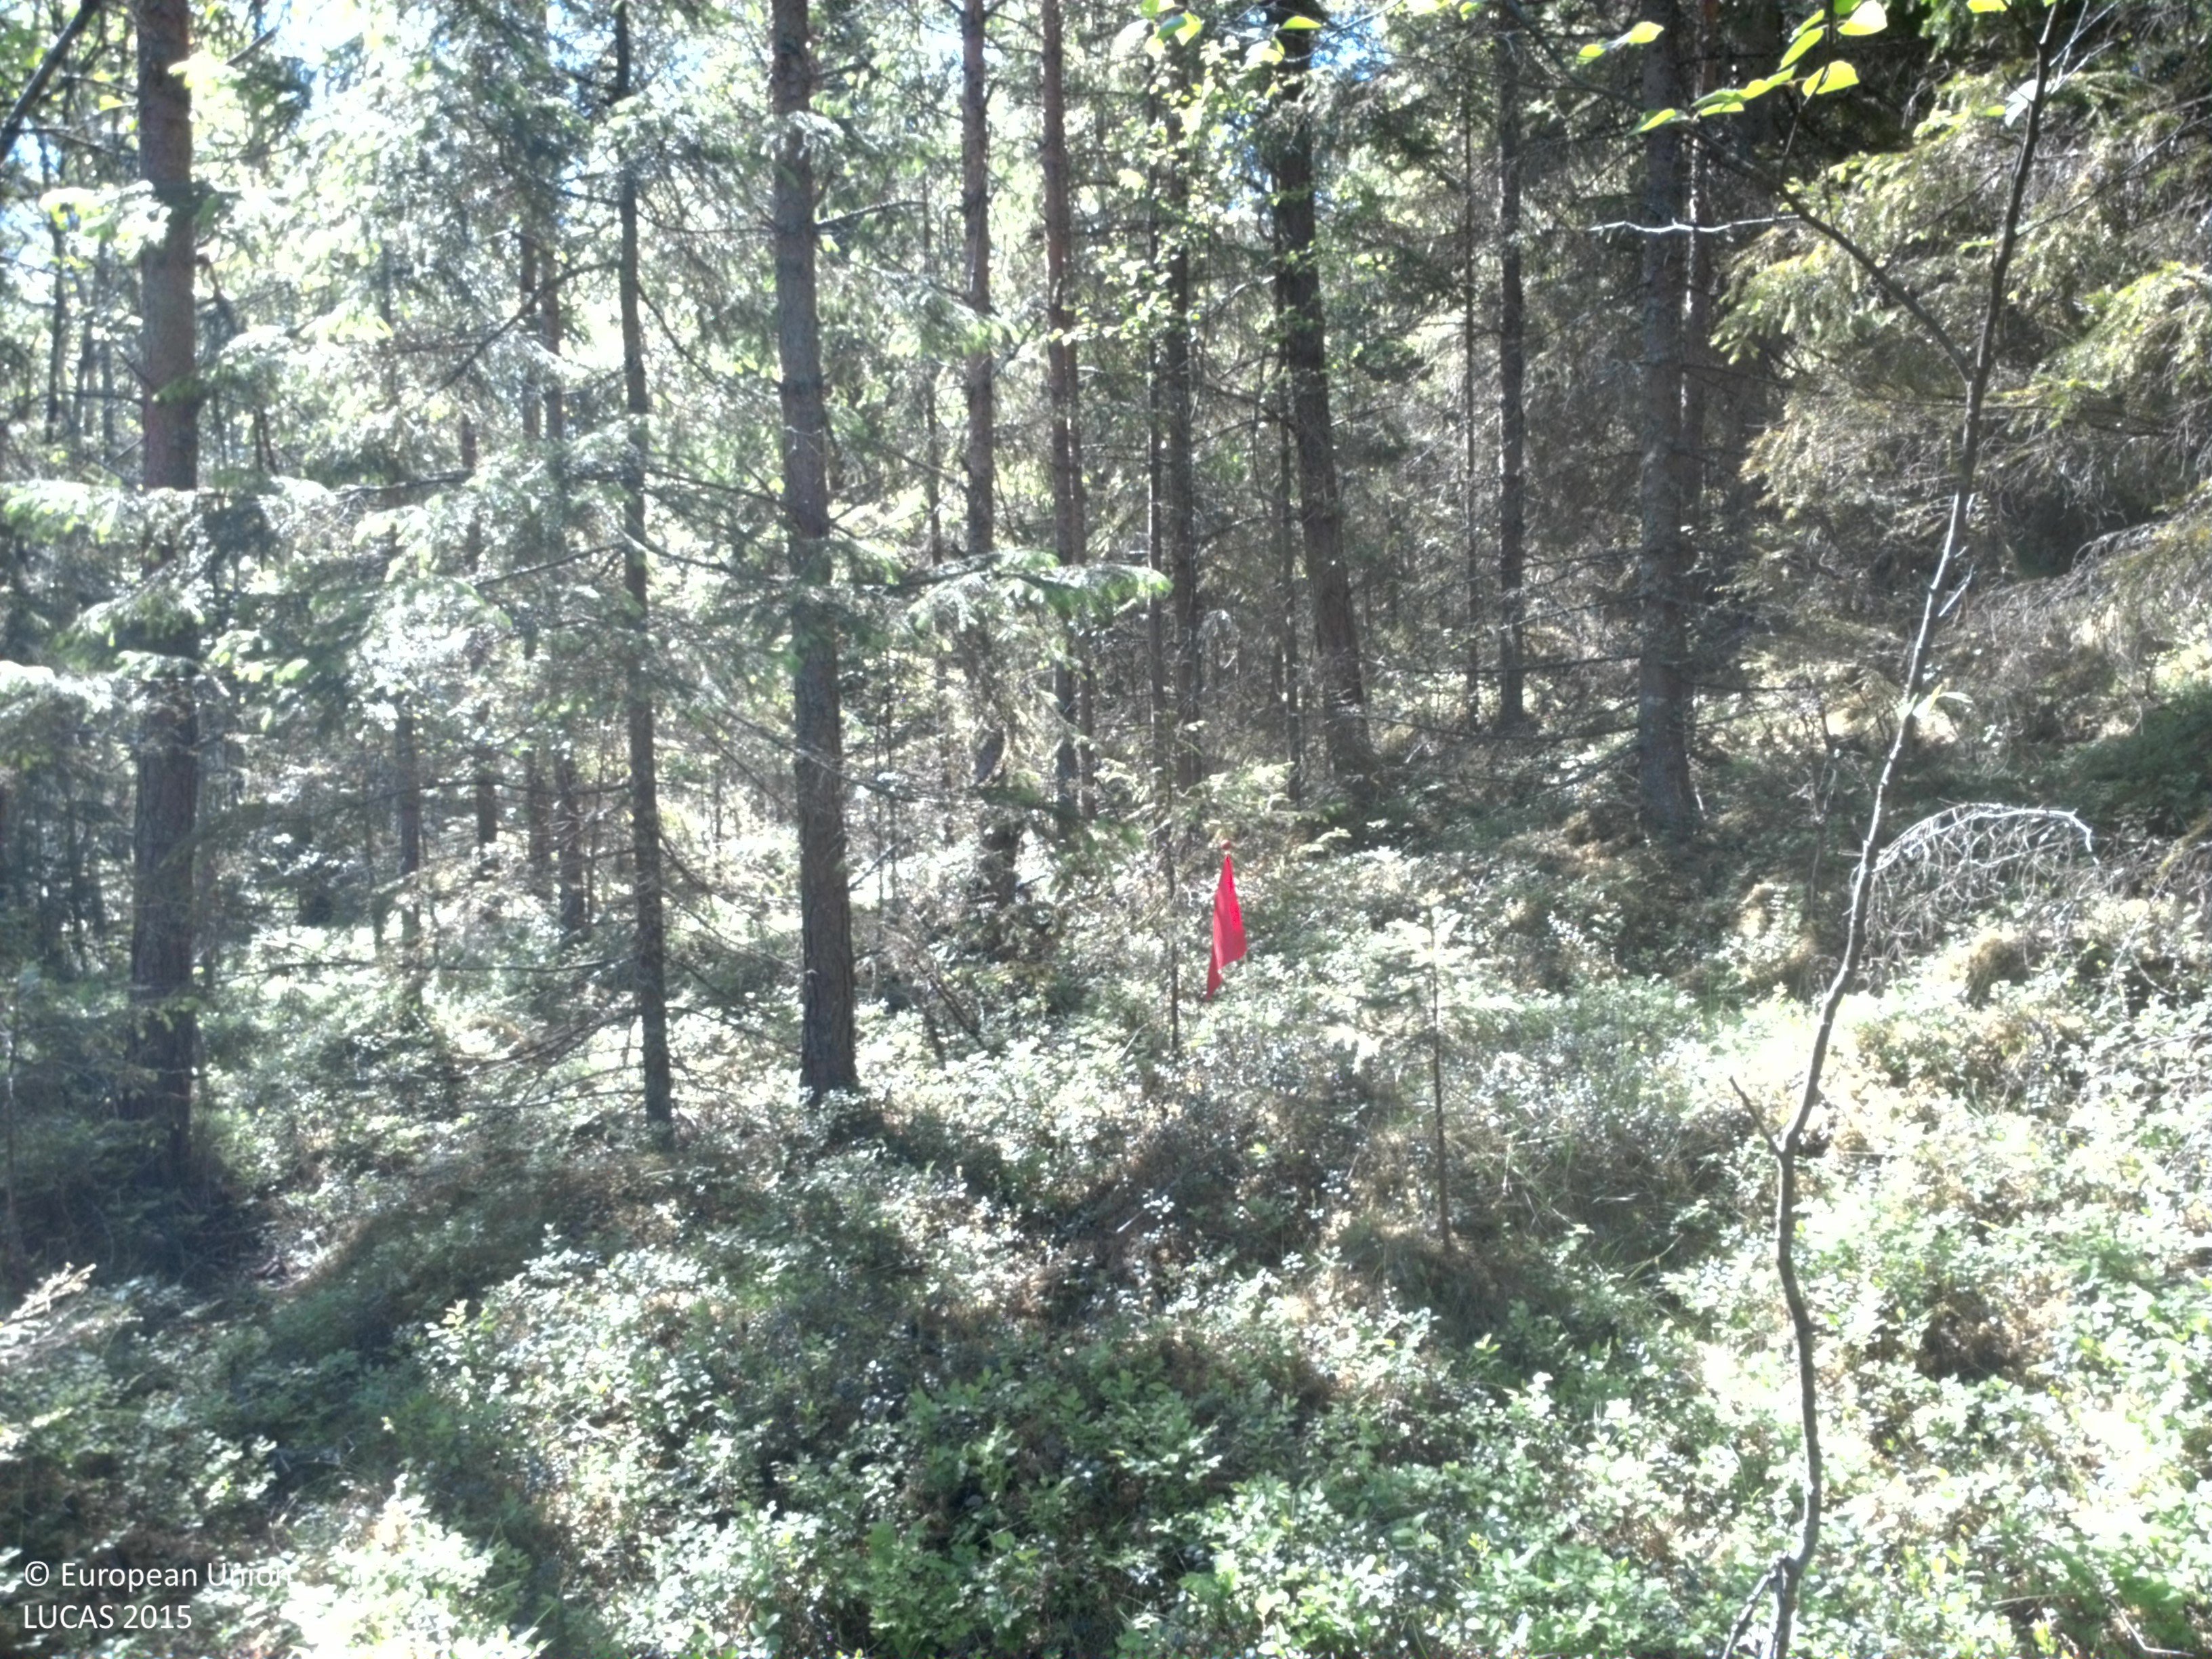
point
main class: Woodland
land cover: Spruce dominated mixed woodland
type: boreal forest
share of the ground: 50 - 75 %
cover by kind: coniferous forest trees 40 %, shrubs 20 %, broadleaved forest trees 15 %, lichens and mosses 15 %, herbaceous plants 10 %
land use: Forestry
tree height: > 5 m
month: June
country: SE
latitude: 59.5184
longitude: 11.9919
